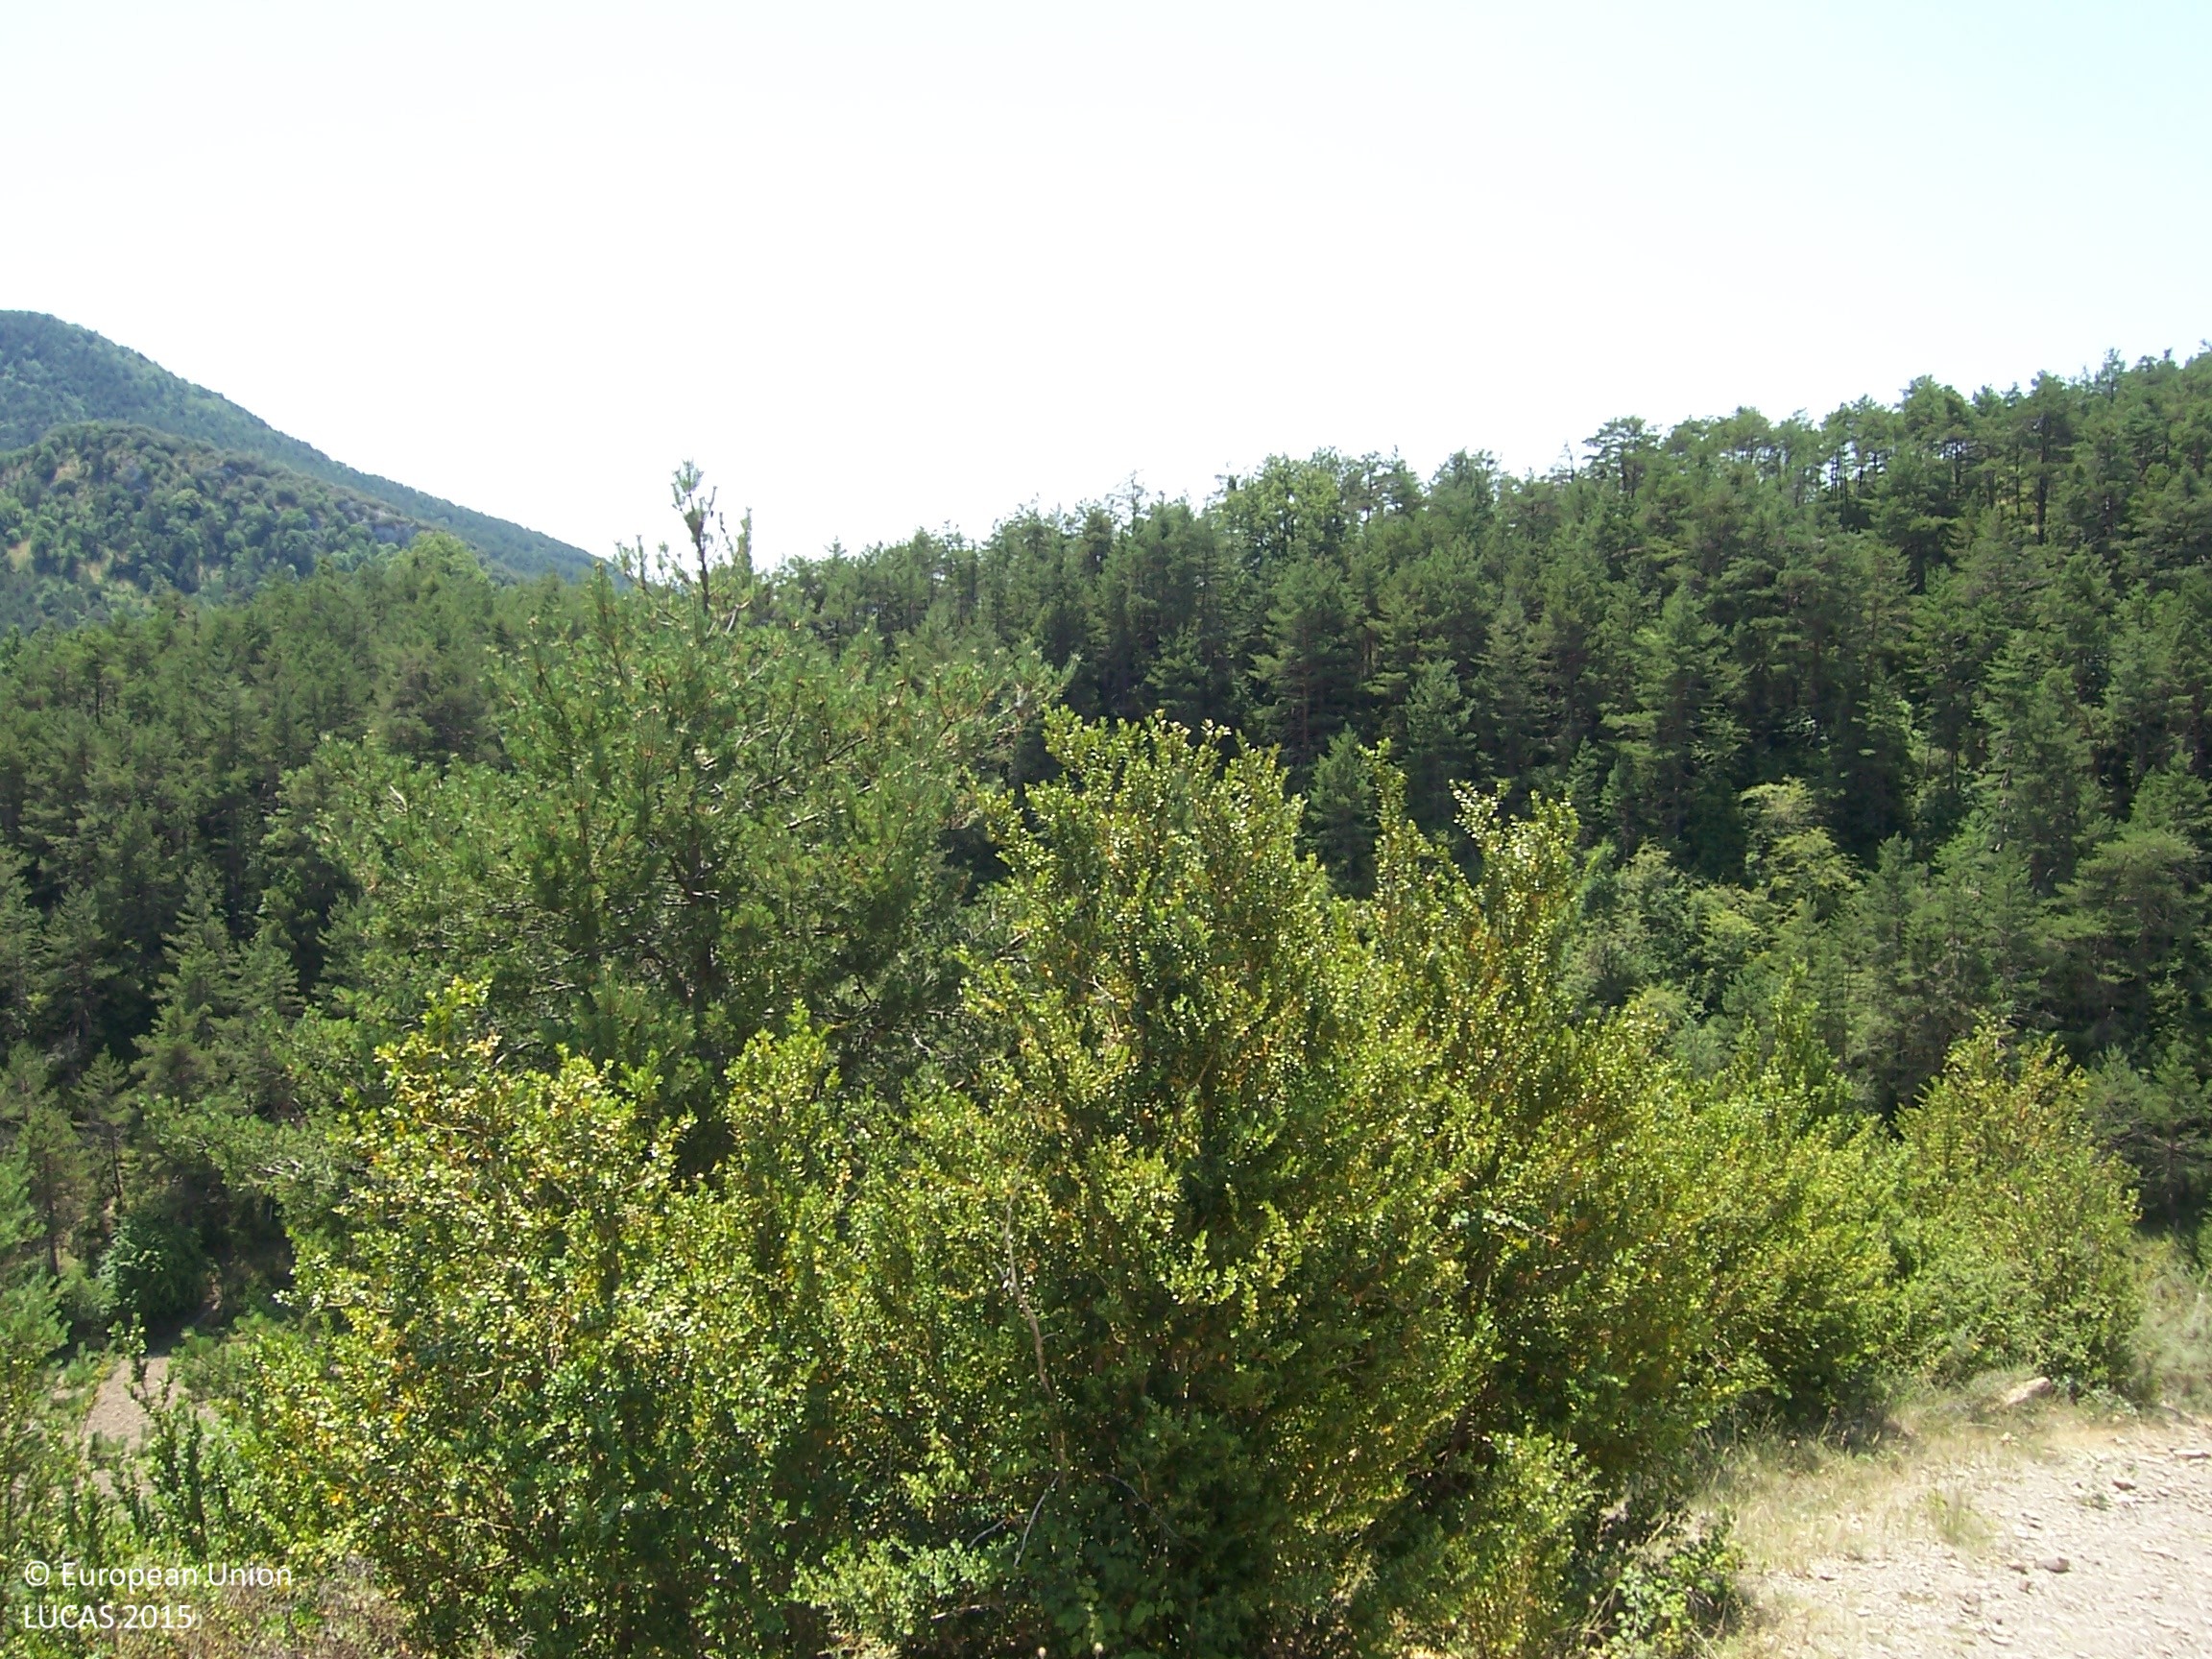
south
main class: Woodland
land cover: Pine dominated coniferous woodland
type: coniferous forest of the mediterranean region
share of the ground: > 75 %
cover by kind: coniferous forest trees 100 %
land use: Forestry
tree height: > 5 m
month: July
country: ES
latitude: 42.8263
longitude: -1.2524
